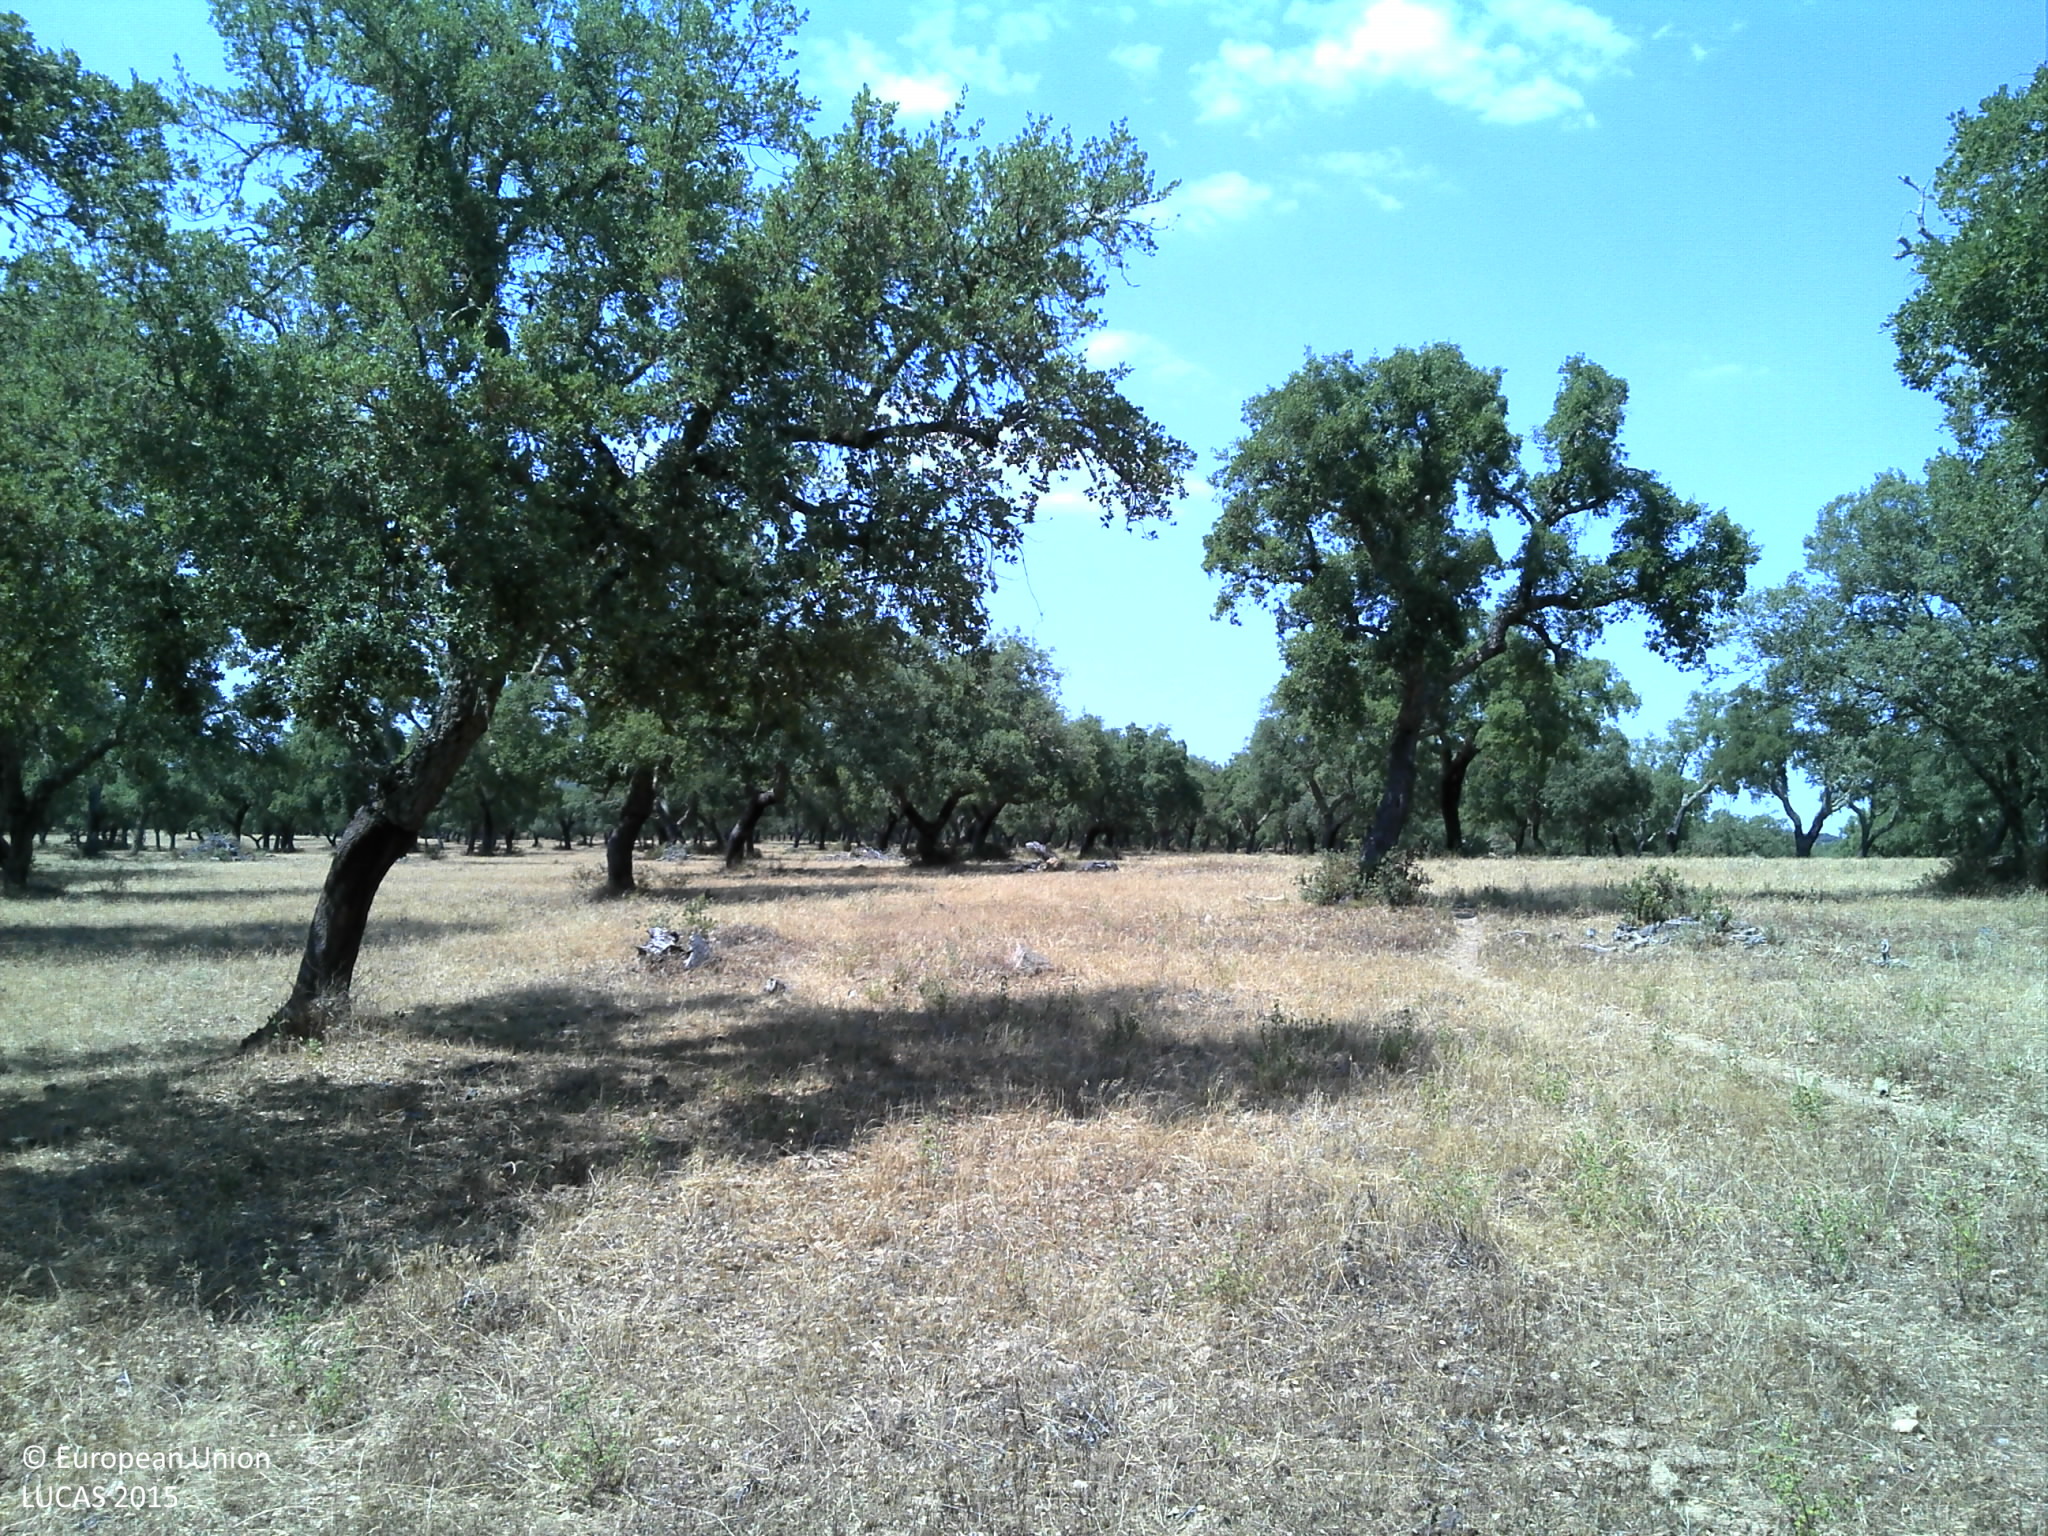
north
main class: Woodland
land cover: Broadleaved woodland
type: broadleaved evergreen forest
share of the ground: 25 - 50 %
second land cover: Grassland without tree/shrub cover
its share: 25 - 50 %
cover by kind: broadleaved forest trees 40 %, herbaceous plants 30 %, unconsolidated bare surface 30 %
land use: Forestry
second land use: Agriculture (excluding fallow land and kitchen gardens)
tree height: > 5 m
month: June
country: PT
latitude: 38.4107
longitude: -8.1483
